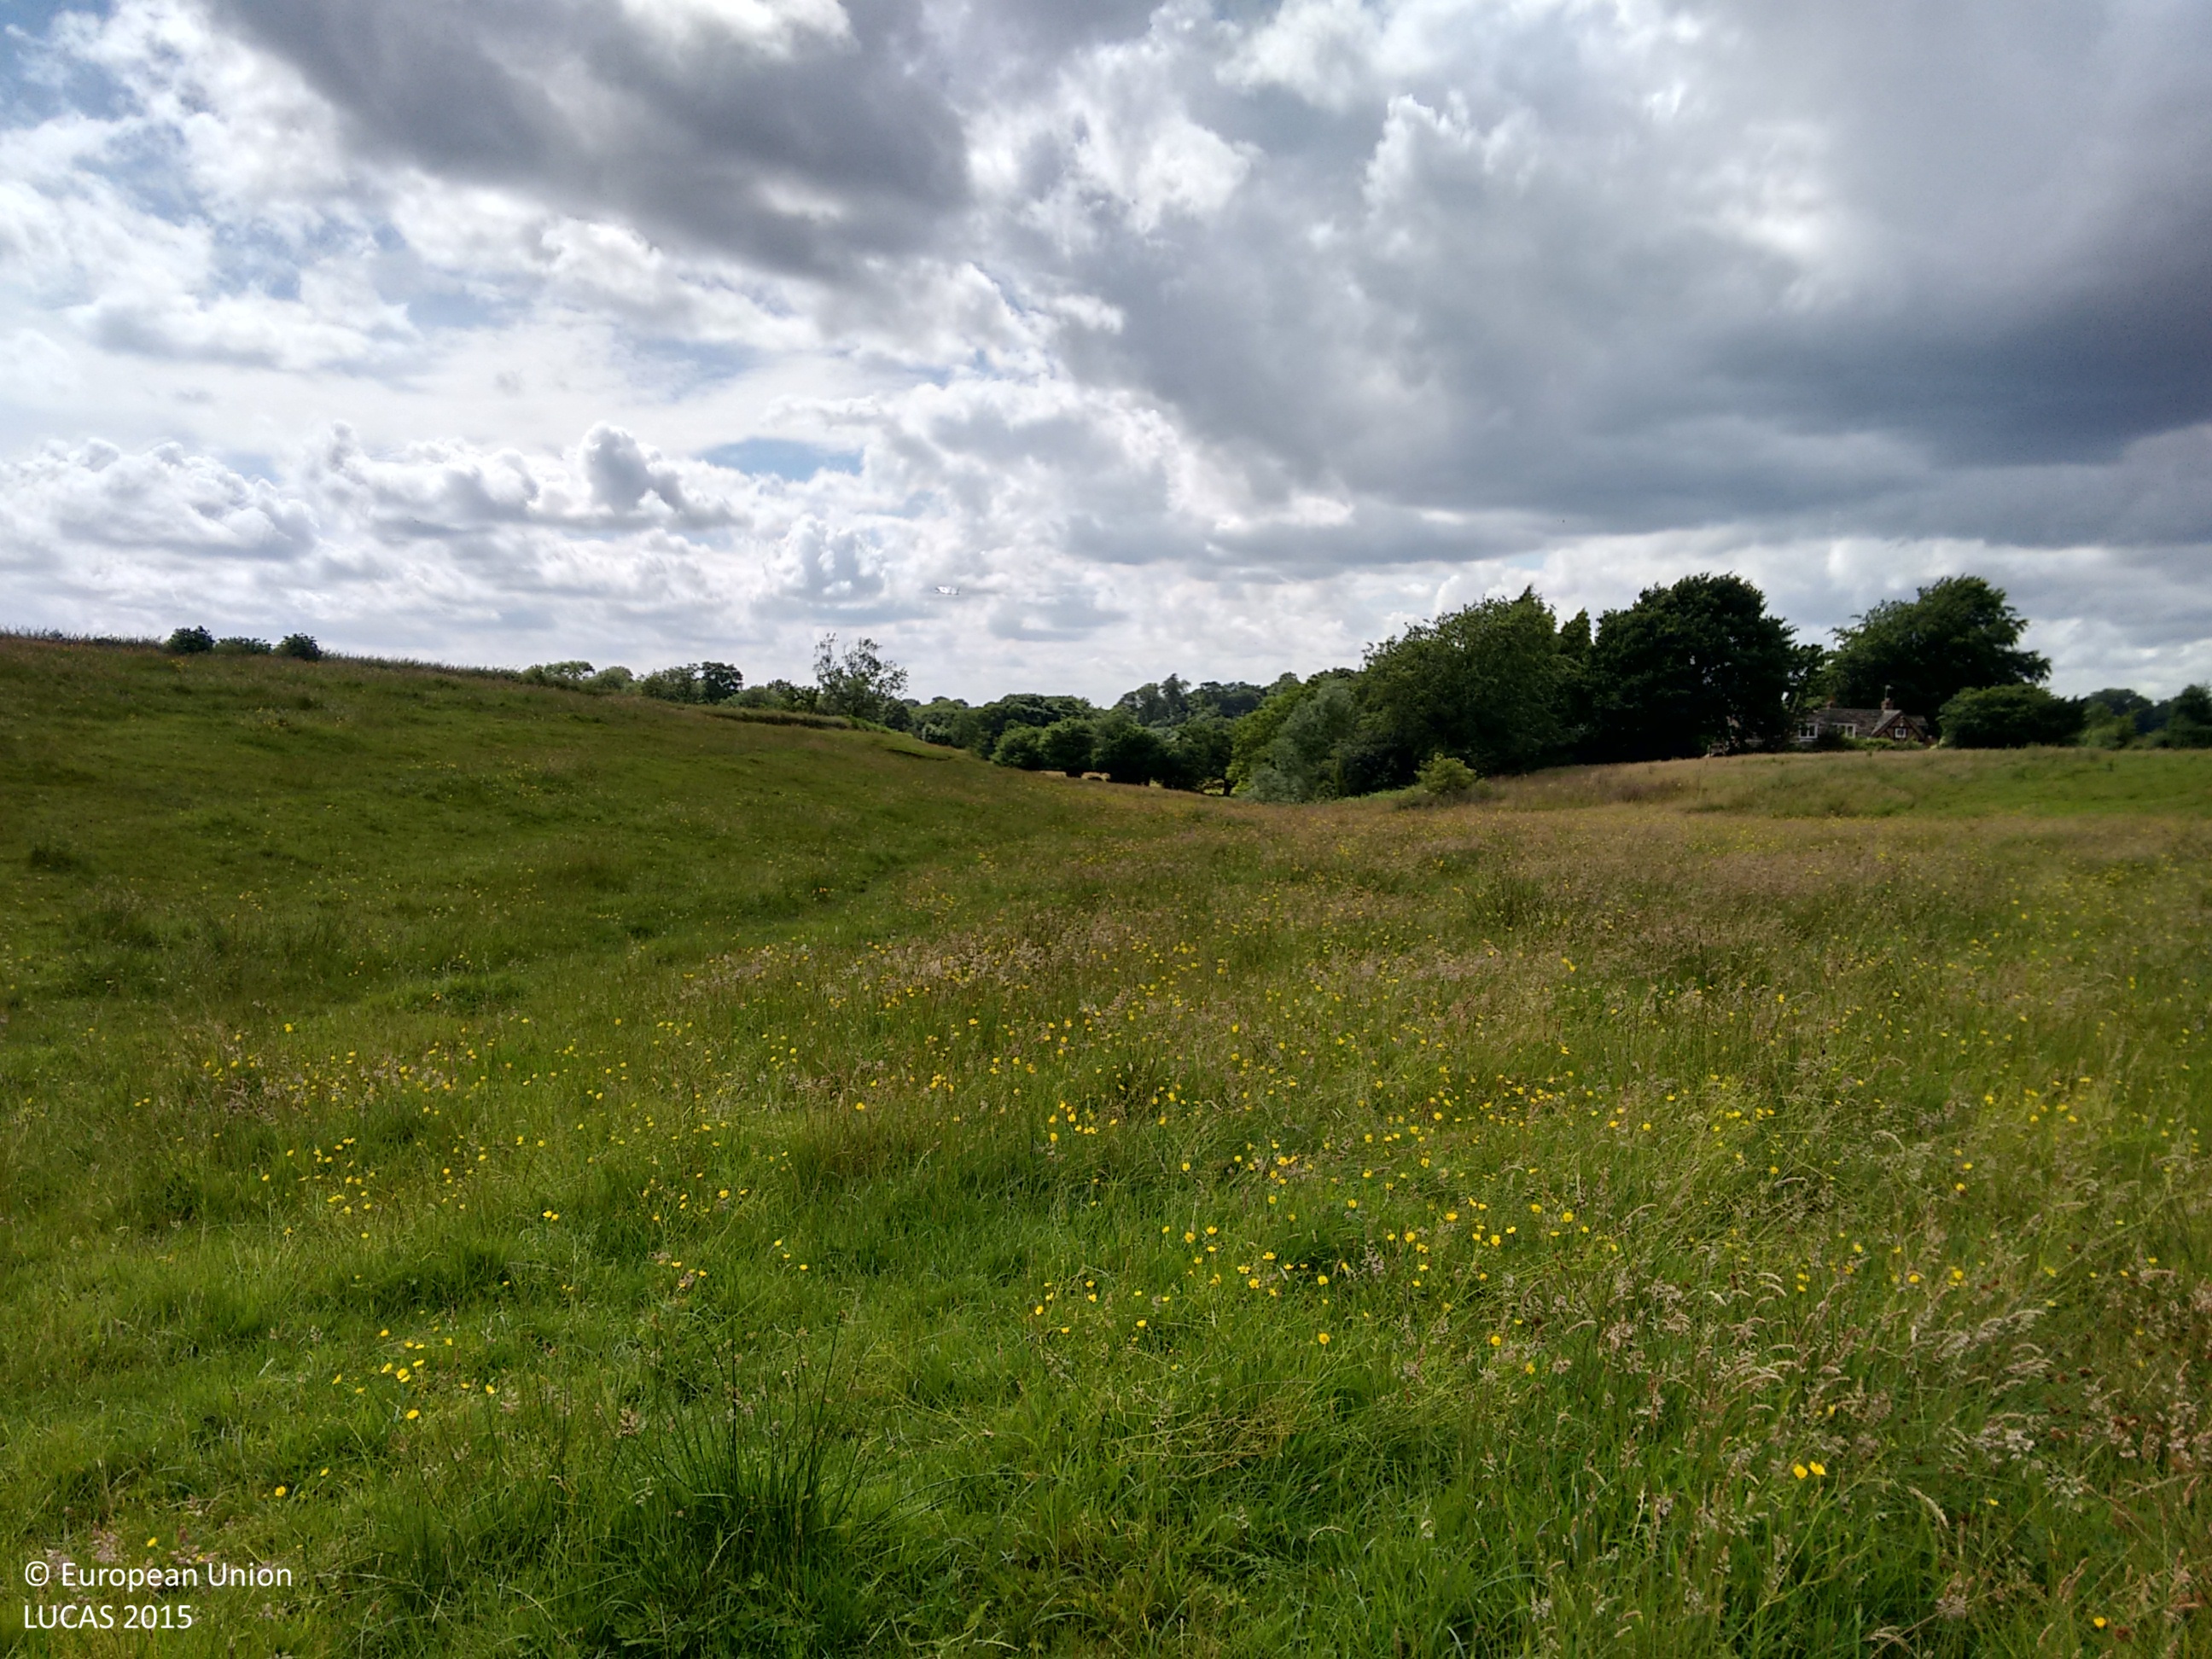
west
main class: Grassland
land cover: Grassland without tree/shrub cover
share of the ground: > 75 %
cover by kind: herbaceous plants 100 %
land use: Agriculture (excluding fallow land and kitchen gardens)
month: July
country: GB
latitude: 53.3389
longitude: -2.2720
